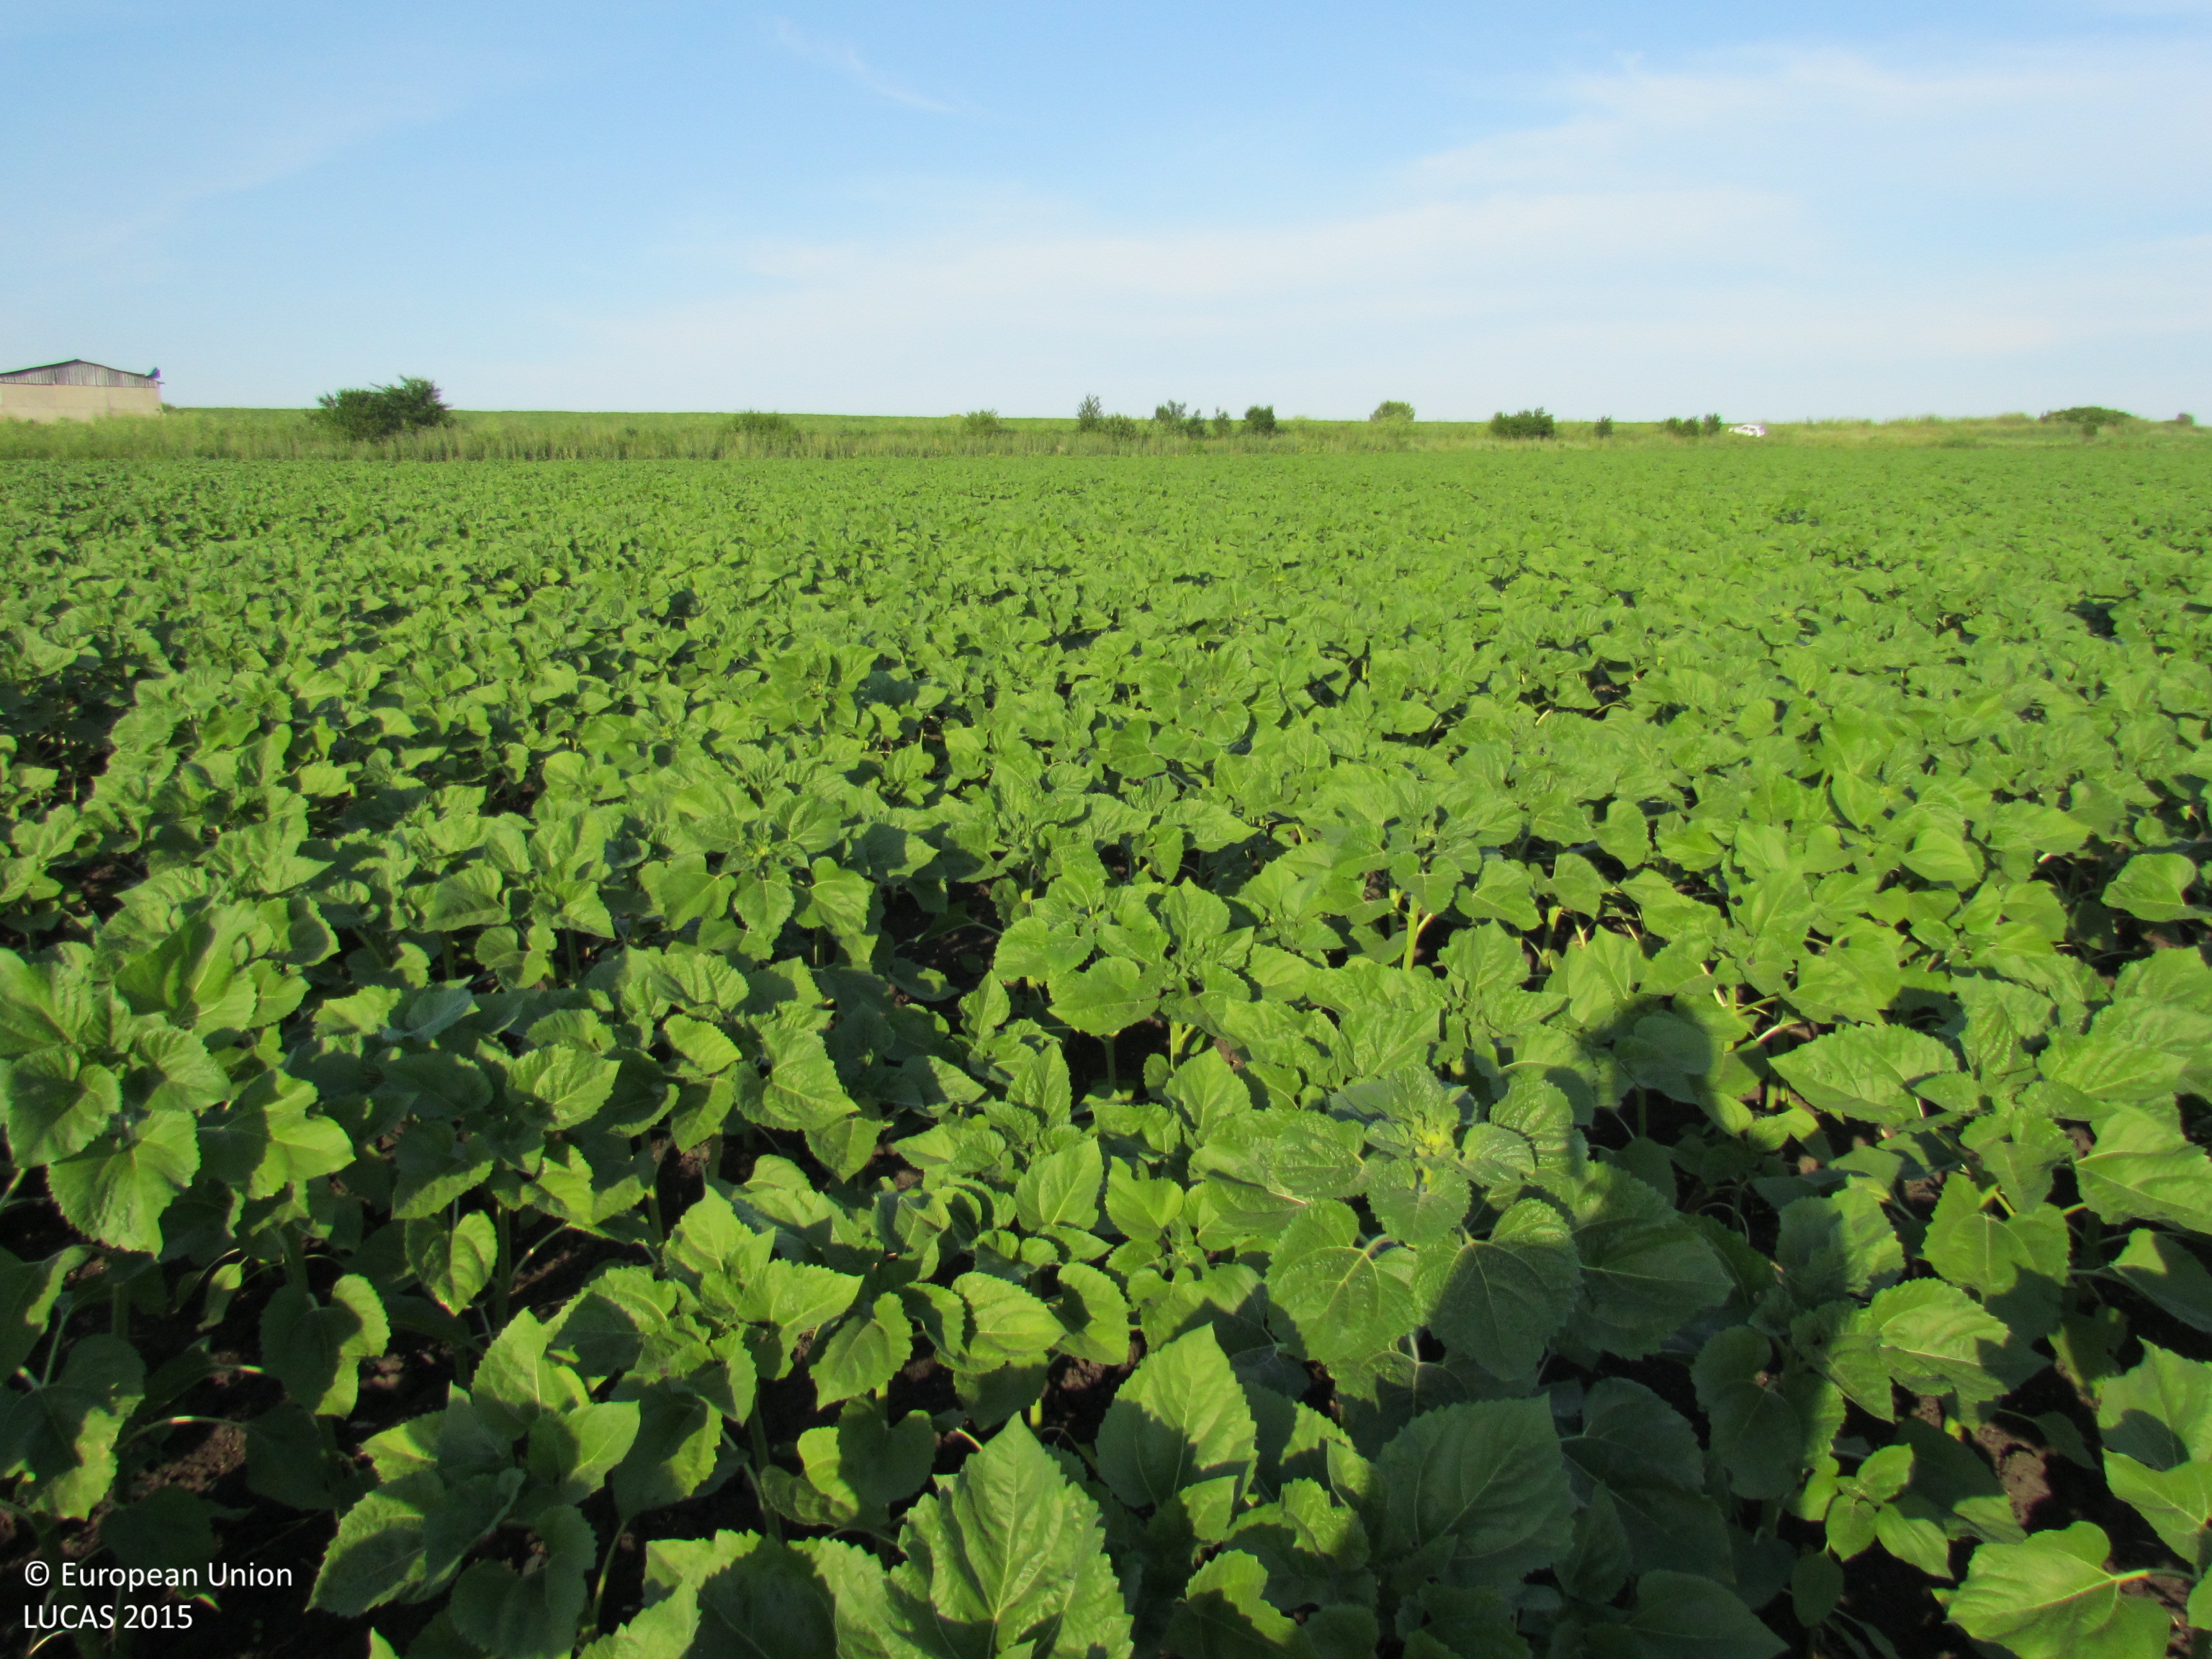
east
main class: Cropland
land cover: Sunflower
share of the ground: > 75 %
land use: Agriculture (excluding fallow land and kitchen gardens)
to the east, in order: Sunflower; Tracks; Grass margins; Ditches and canals; Grass margins; Paved roads, cycling and walking lanes; Grass margins; Ditches and canals; Grass margins; Sunflower
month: June
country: BG
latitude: 42.4600
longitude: 27.1950
